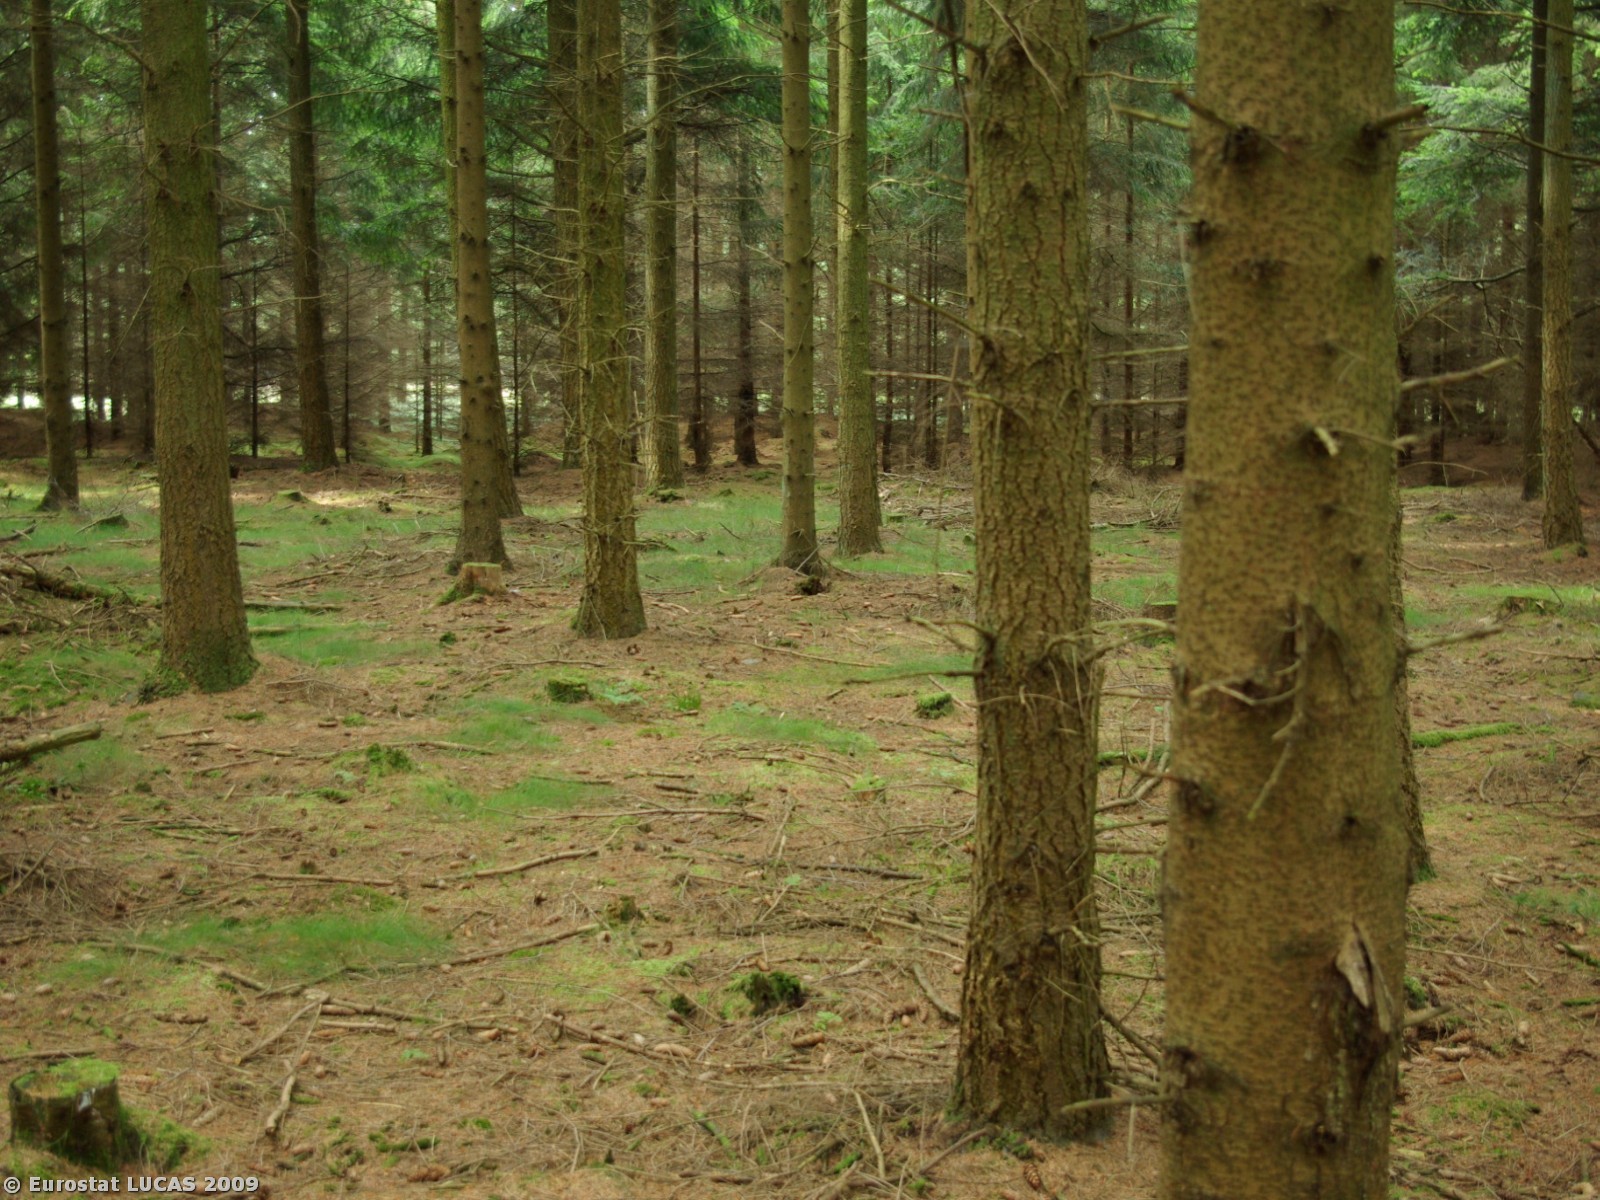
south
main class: Woodland
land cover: Coniferous woodland
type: hemiboreal forest and nemoral coniferous forest and mixed broadleaved-coniferous forest
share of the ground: > 75 %
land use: Forestry
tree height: > 5 m
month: July
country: DK
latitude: 54.8198
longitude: 9.3002
